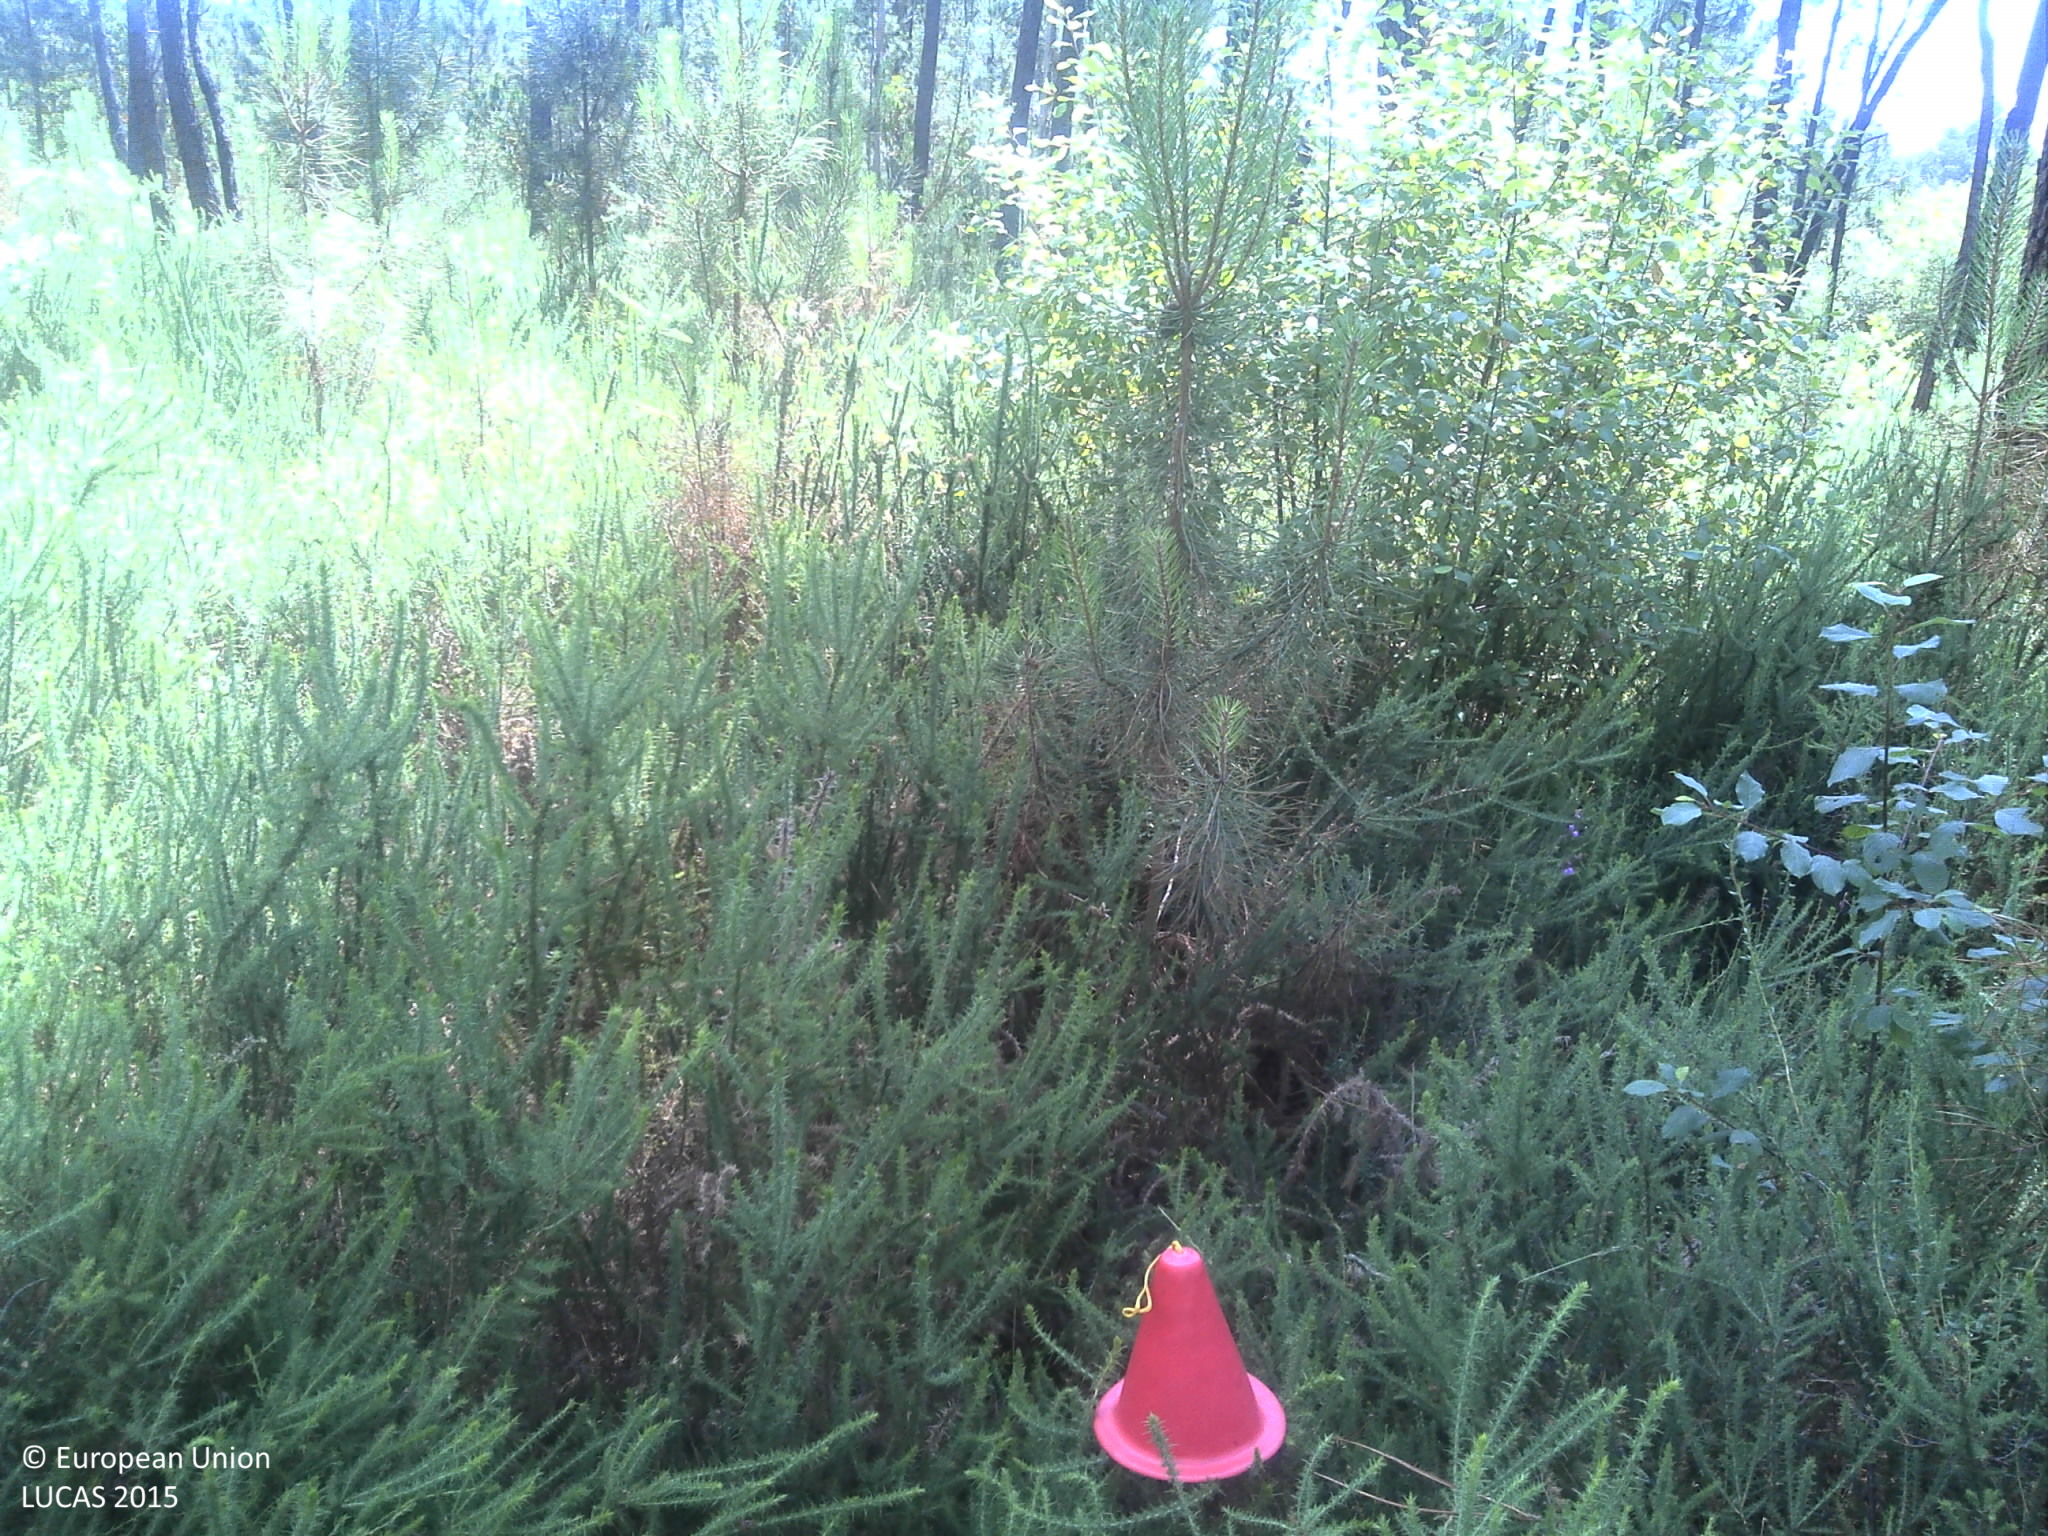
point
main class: Woodland
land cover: Pine dominated coniferous woodland
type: coniferous forest of the mediterranean region
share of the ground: 50 - 75 %
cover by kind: coniferous forest trees 70 %, shrubs 25 %, broadleaved forest trees 5 %
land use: Forestry
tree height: > 5 m
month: June
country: PT
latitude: 41.6234
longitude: -8.5585
